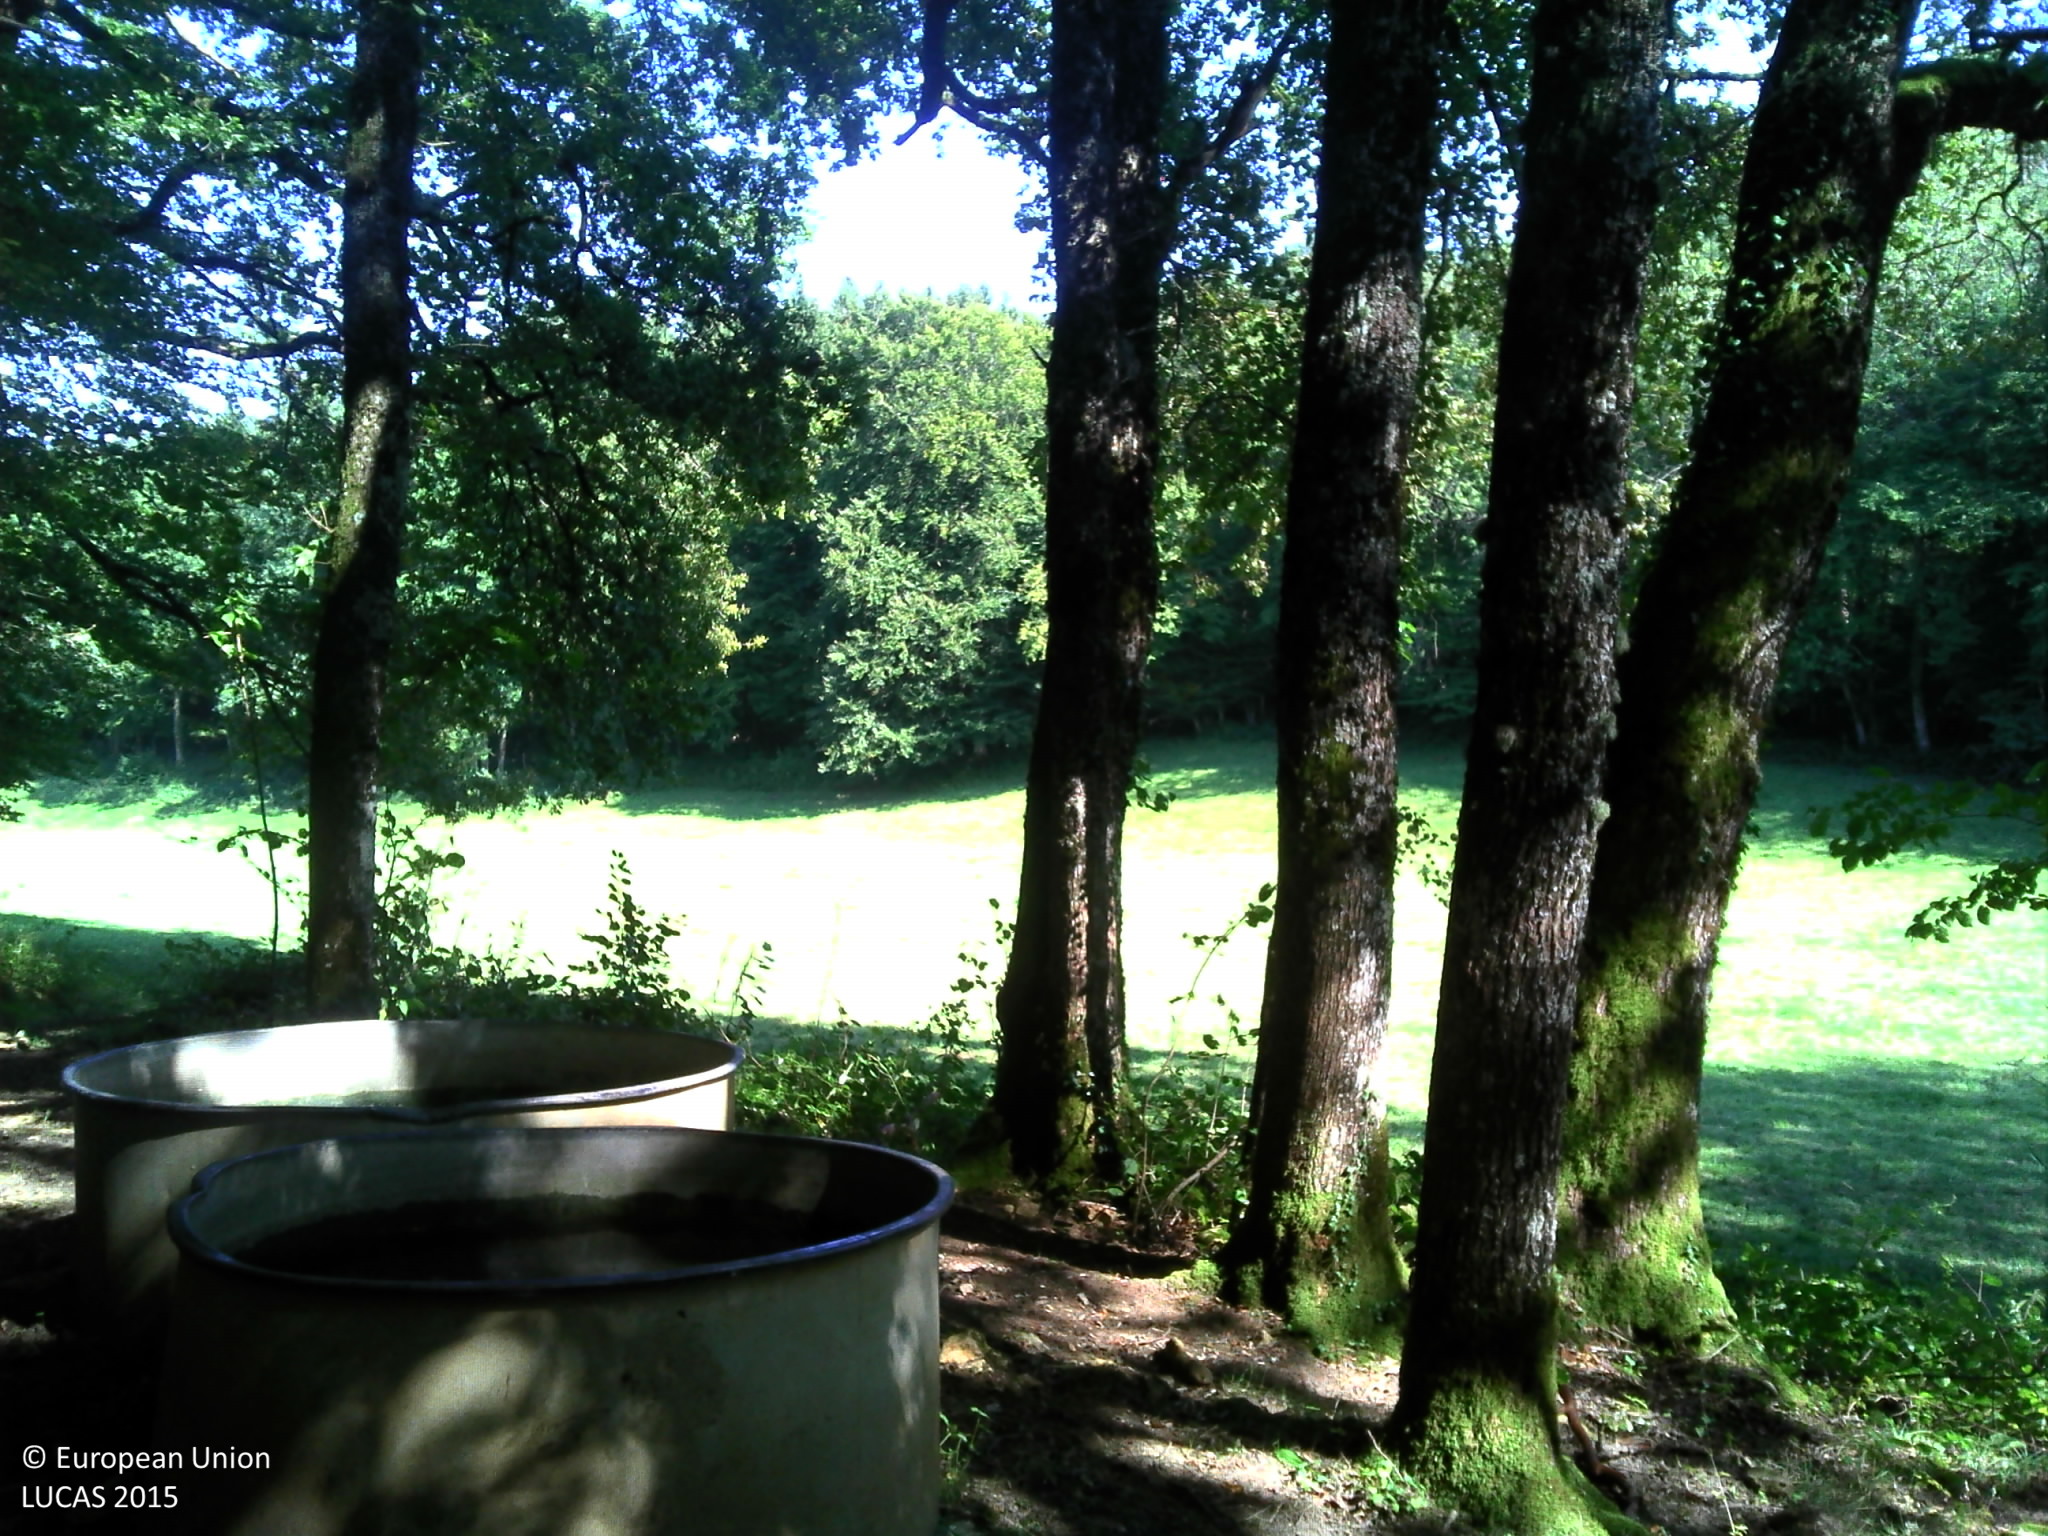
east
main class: Woodland
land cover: Broadleaved woodland
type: beech forest
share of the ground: > 75 %
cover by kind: broadleaved forest trees 90 %, unconsolidated bare surface 10 %
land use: Forestry
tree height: > 5 m
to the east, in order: Broadleaved woodland; Grassland without tree/shrub cover; Spontaneously vegetated surfaces; Fences; Spruce dominated mixed woodland
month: September
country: FR
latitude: 47.2431
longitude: 6.3160
